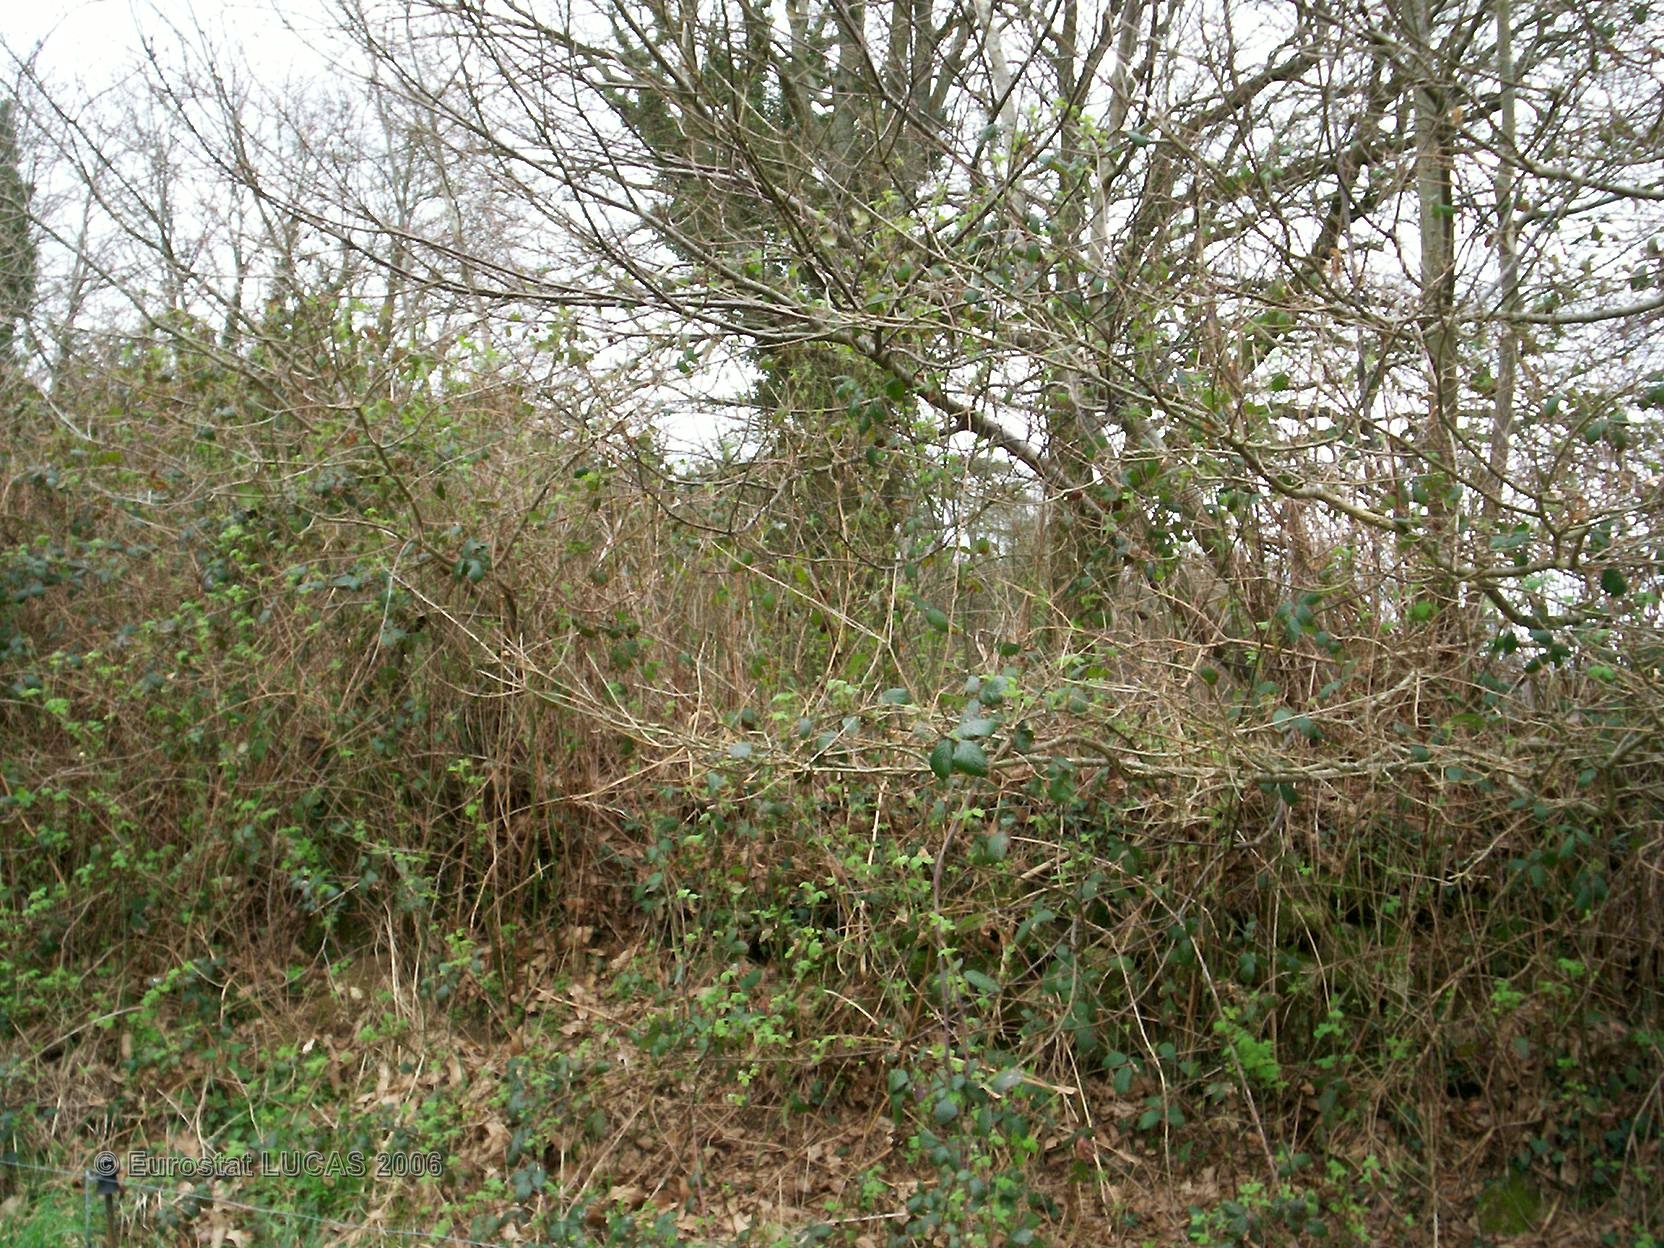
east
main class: Grassland
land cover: Grassland without tree/shrub cover
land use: Agriculture (excluding fallow land and kitchen gardens)
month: April
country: FR
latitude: 47.9530
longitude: -3.5071
